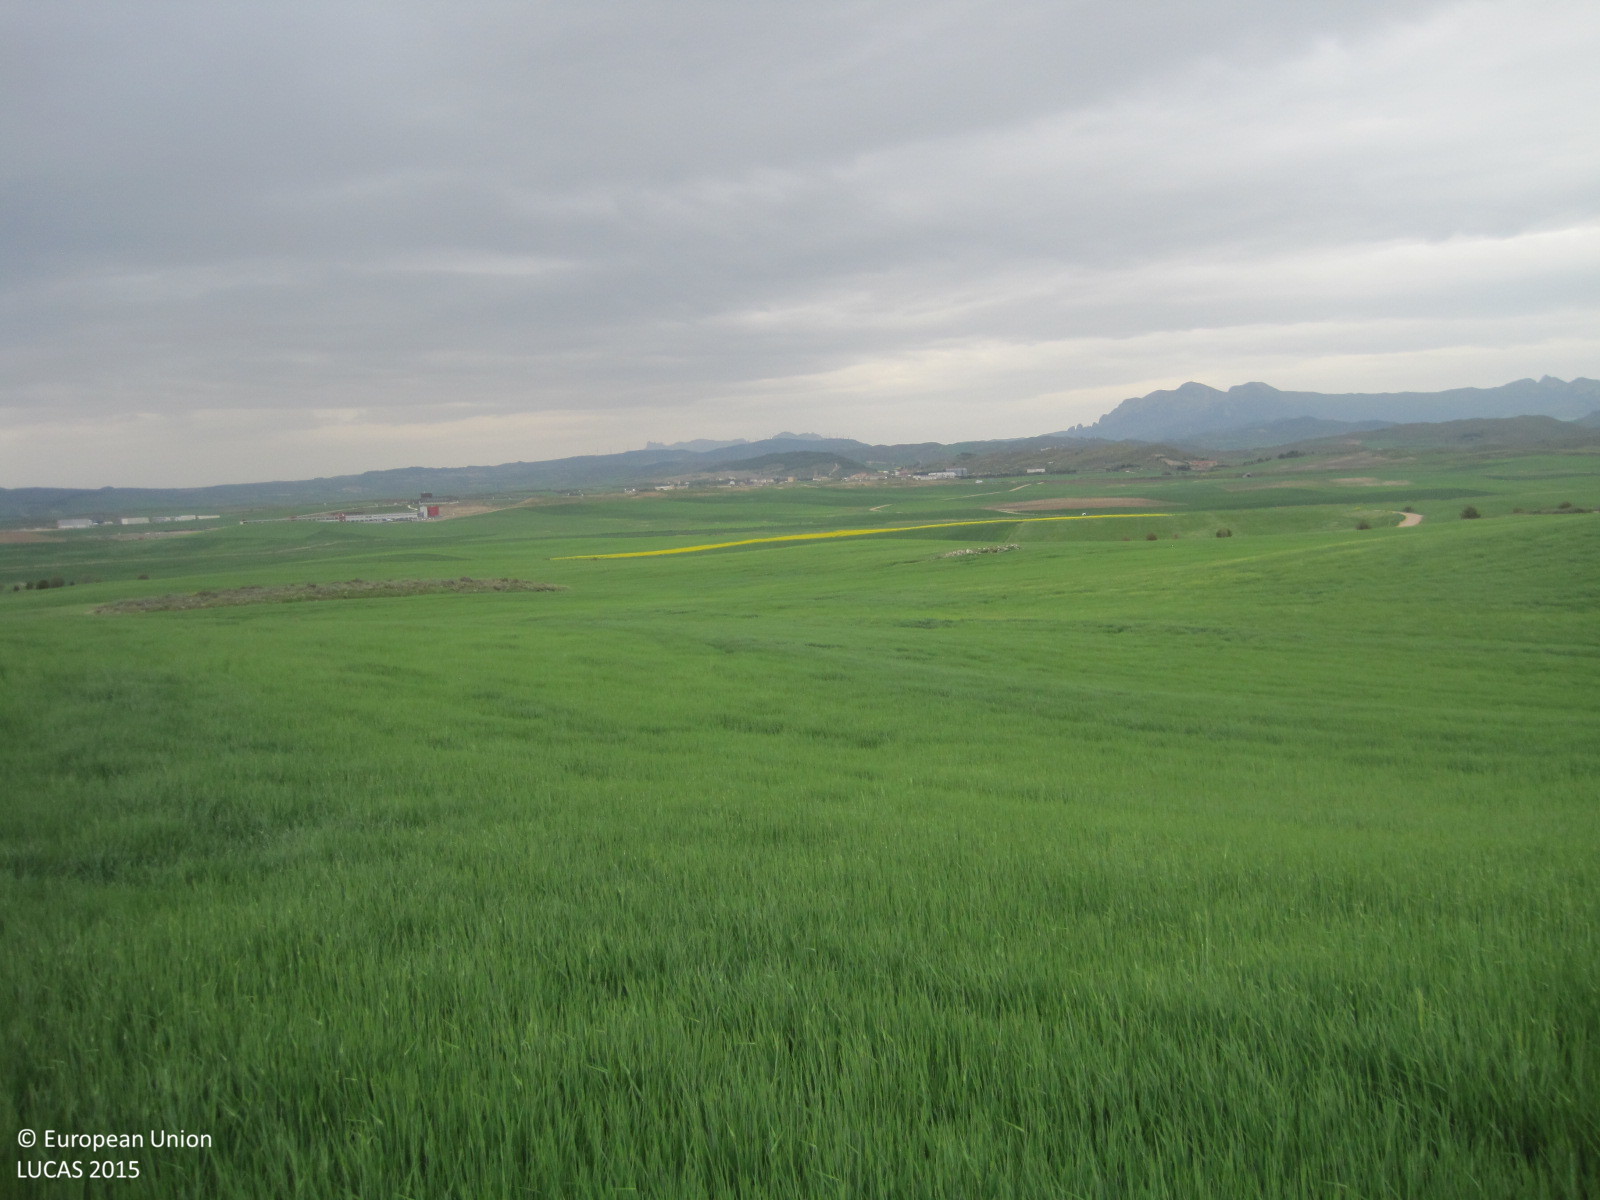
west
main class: Cropland
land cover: Barley
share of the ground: > 75 %
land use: Agriculture (excluding fallow land and kitchen gardens)
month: April
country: ES
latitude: 42.5597
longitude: -2.1369
